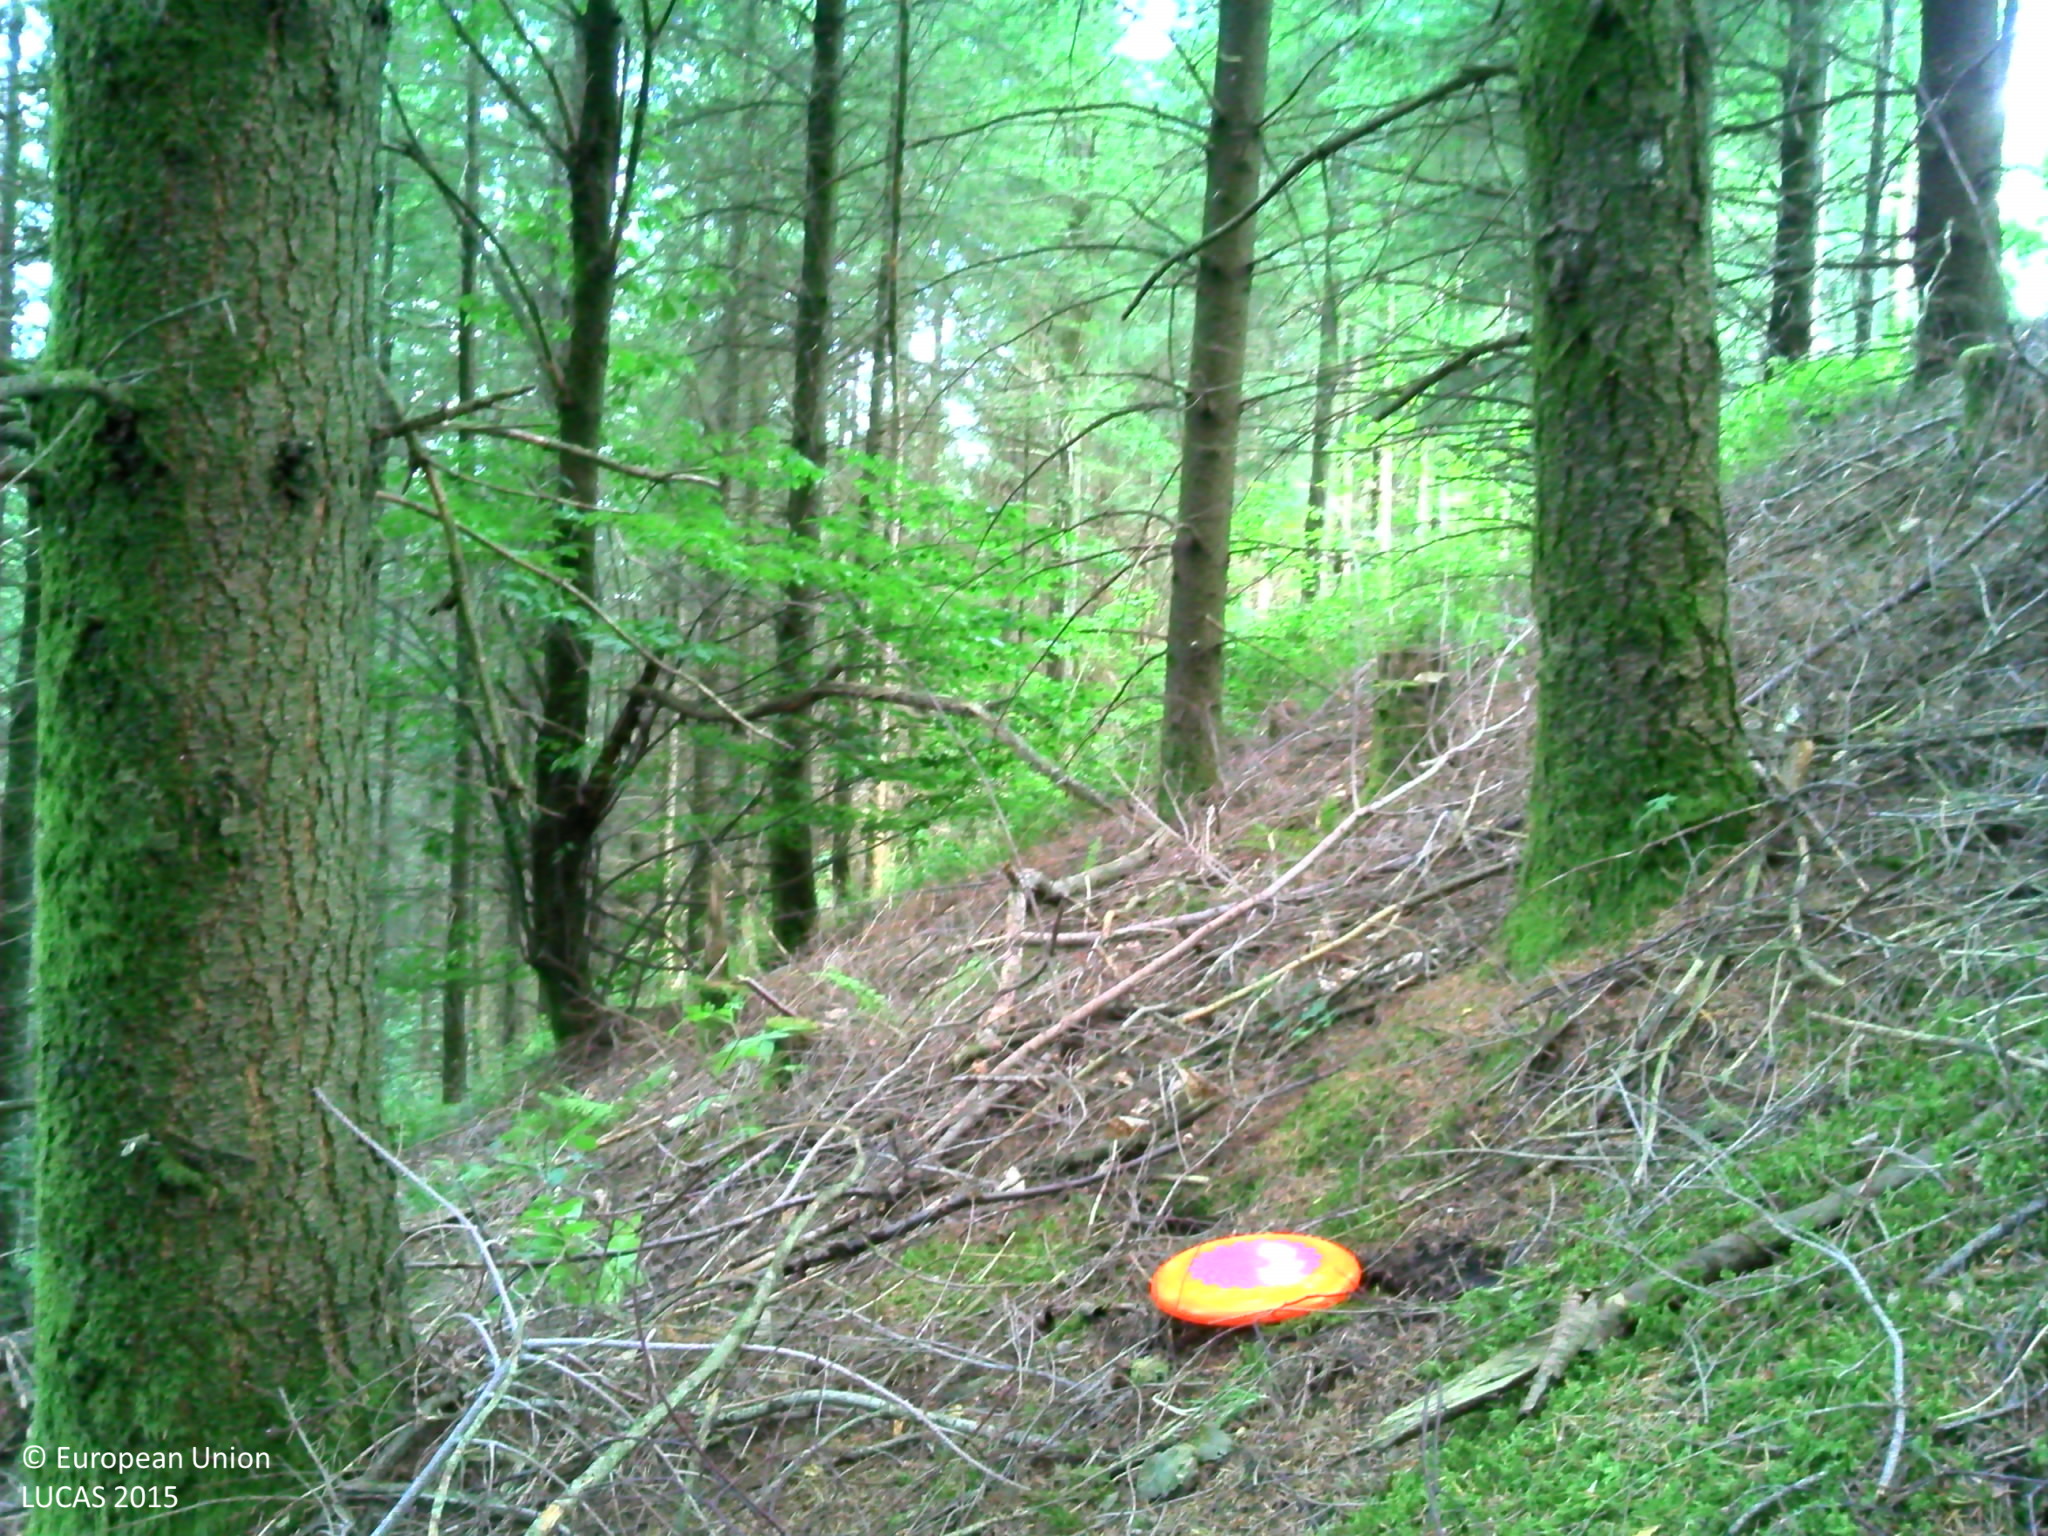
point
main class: Woodland
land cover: Spruce dominated coniferous woodland
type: exotic forest
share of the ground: > 75 %
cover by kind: coniferous forest trees 70 %, lichens and mosses 20 %, herbaceous plants 10 %
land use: Forestry
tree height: > 5 m
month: July
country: FR
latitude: 45.6514
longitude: 1.7433
